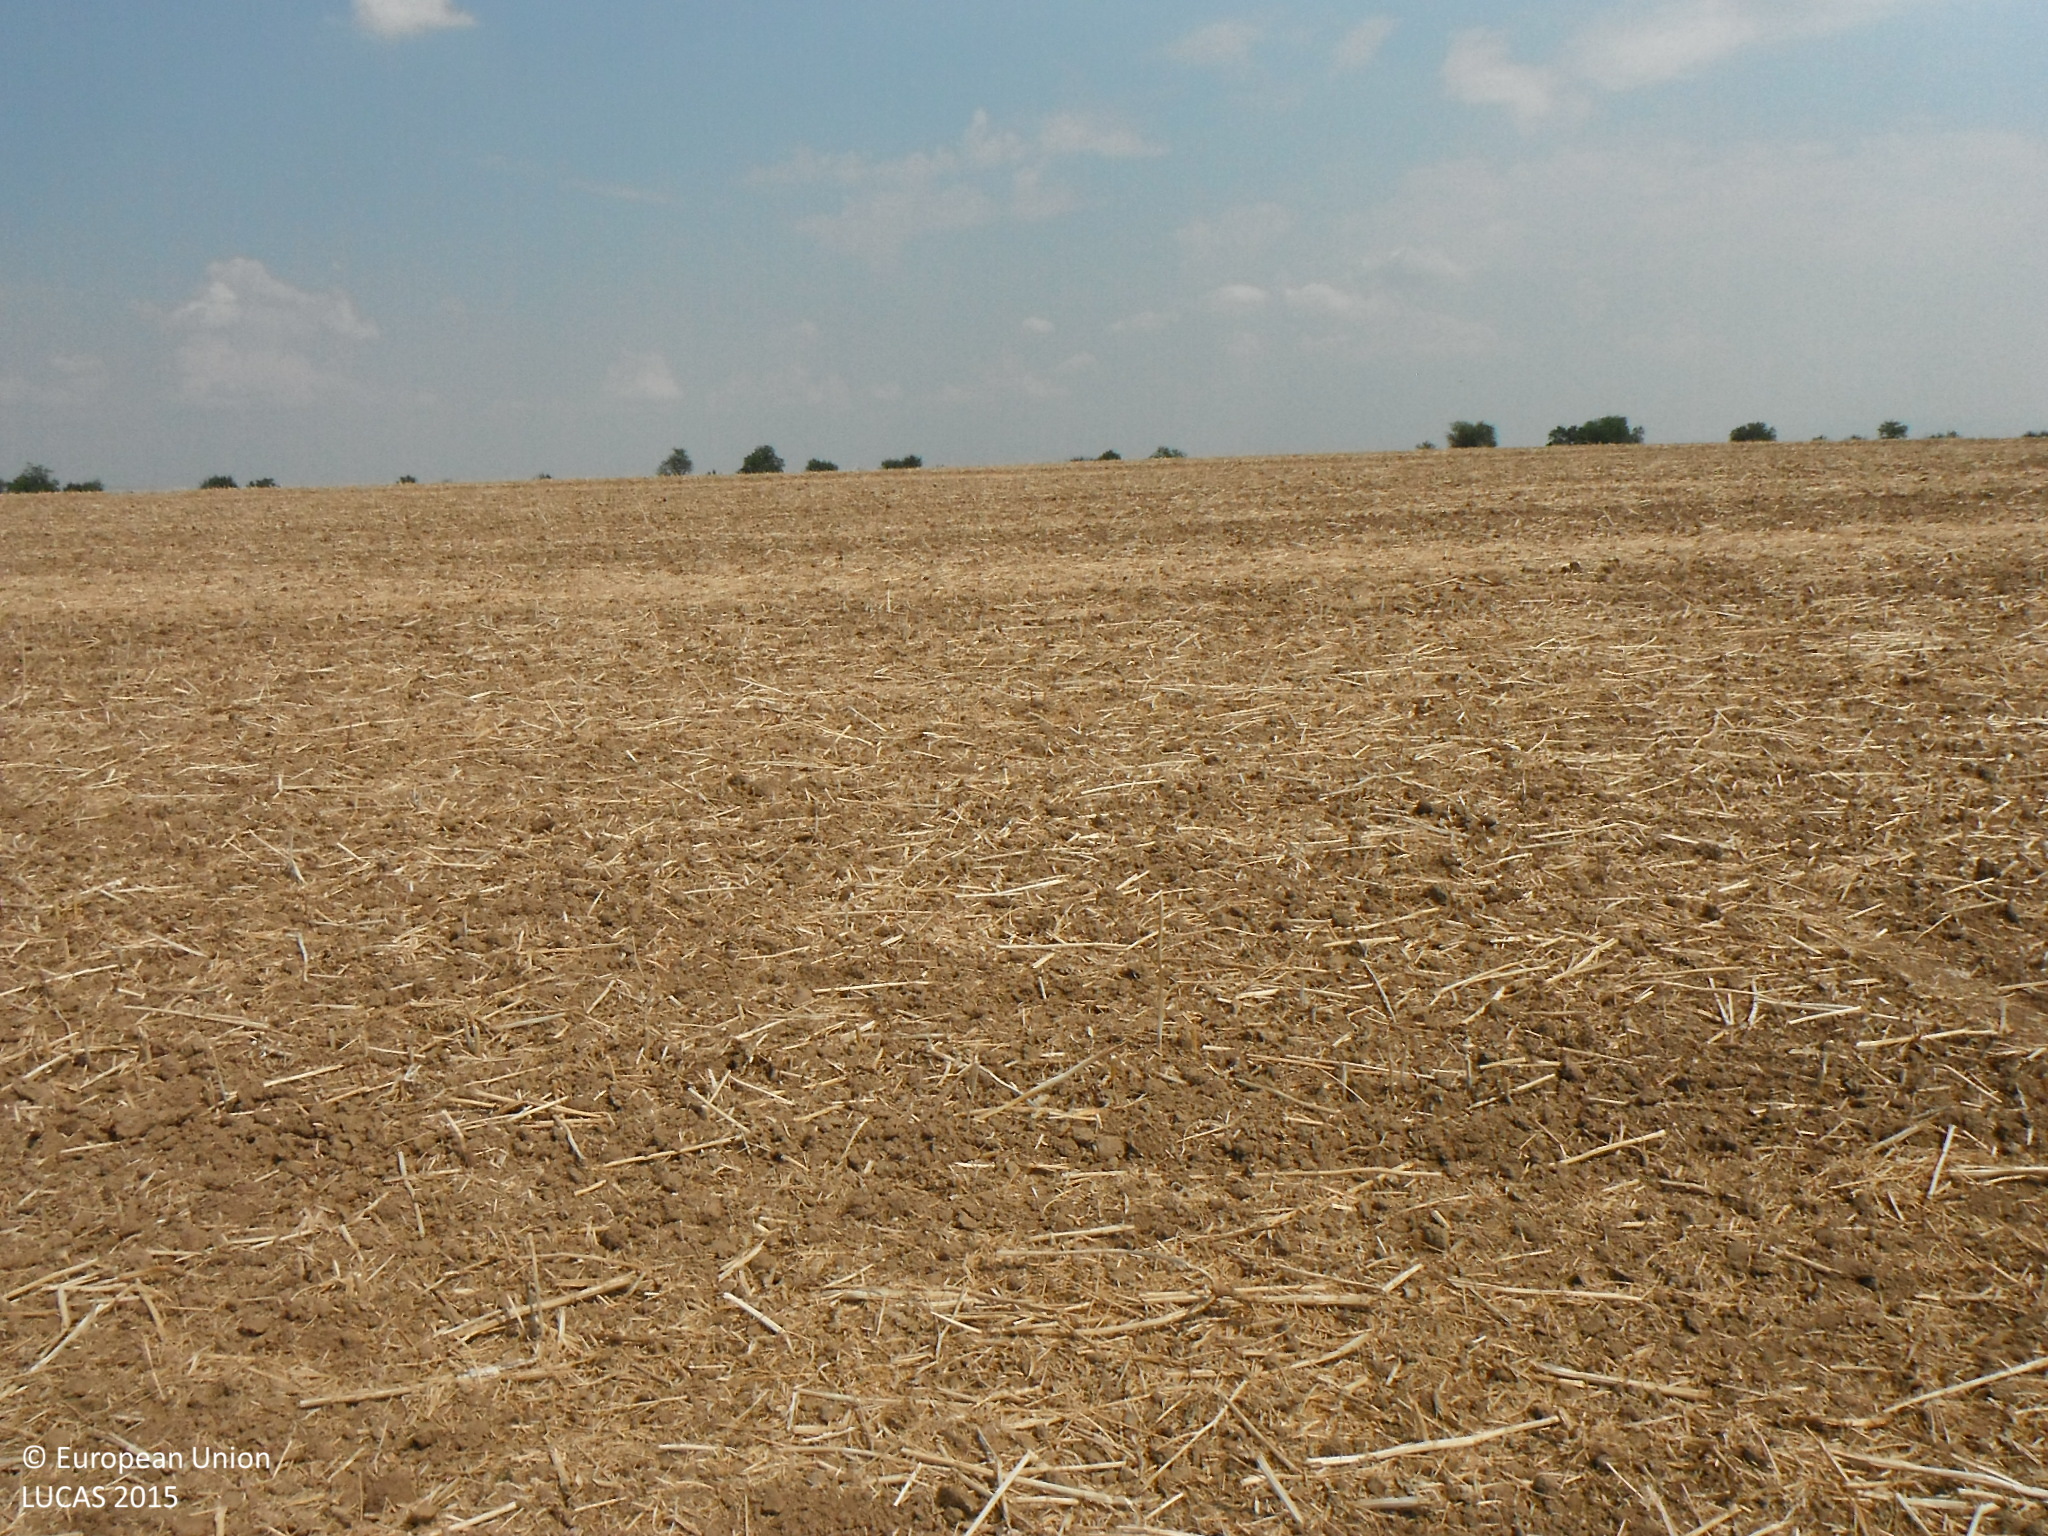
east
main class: Cropland
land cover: Rape and turnip rape
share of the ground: > 75 %
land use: Agriculture (excluding fallow land and kitchen gardens)
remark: Harvested field
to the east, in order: Rape and turnip rape
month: July
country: SK
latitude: 48.1703
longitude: 18.4468
